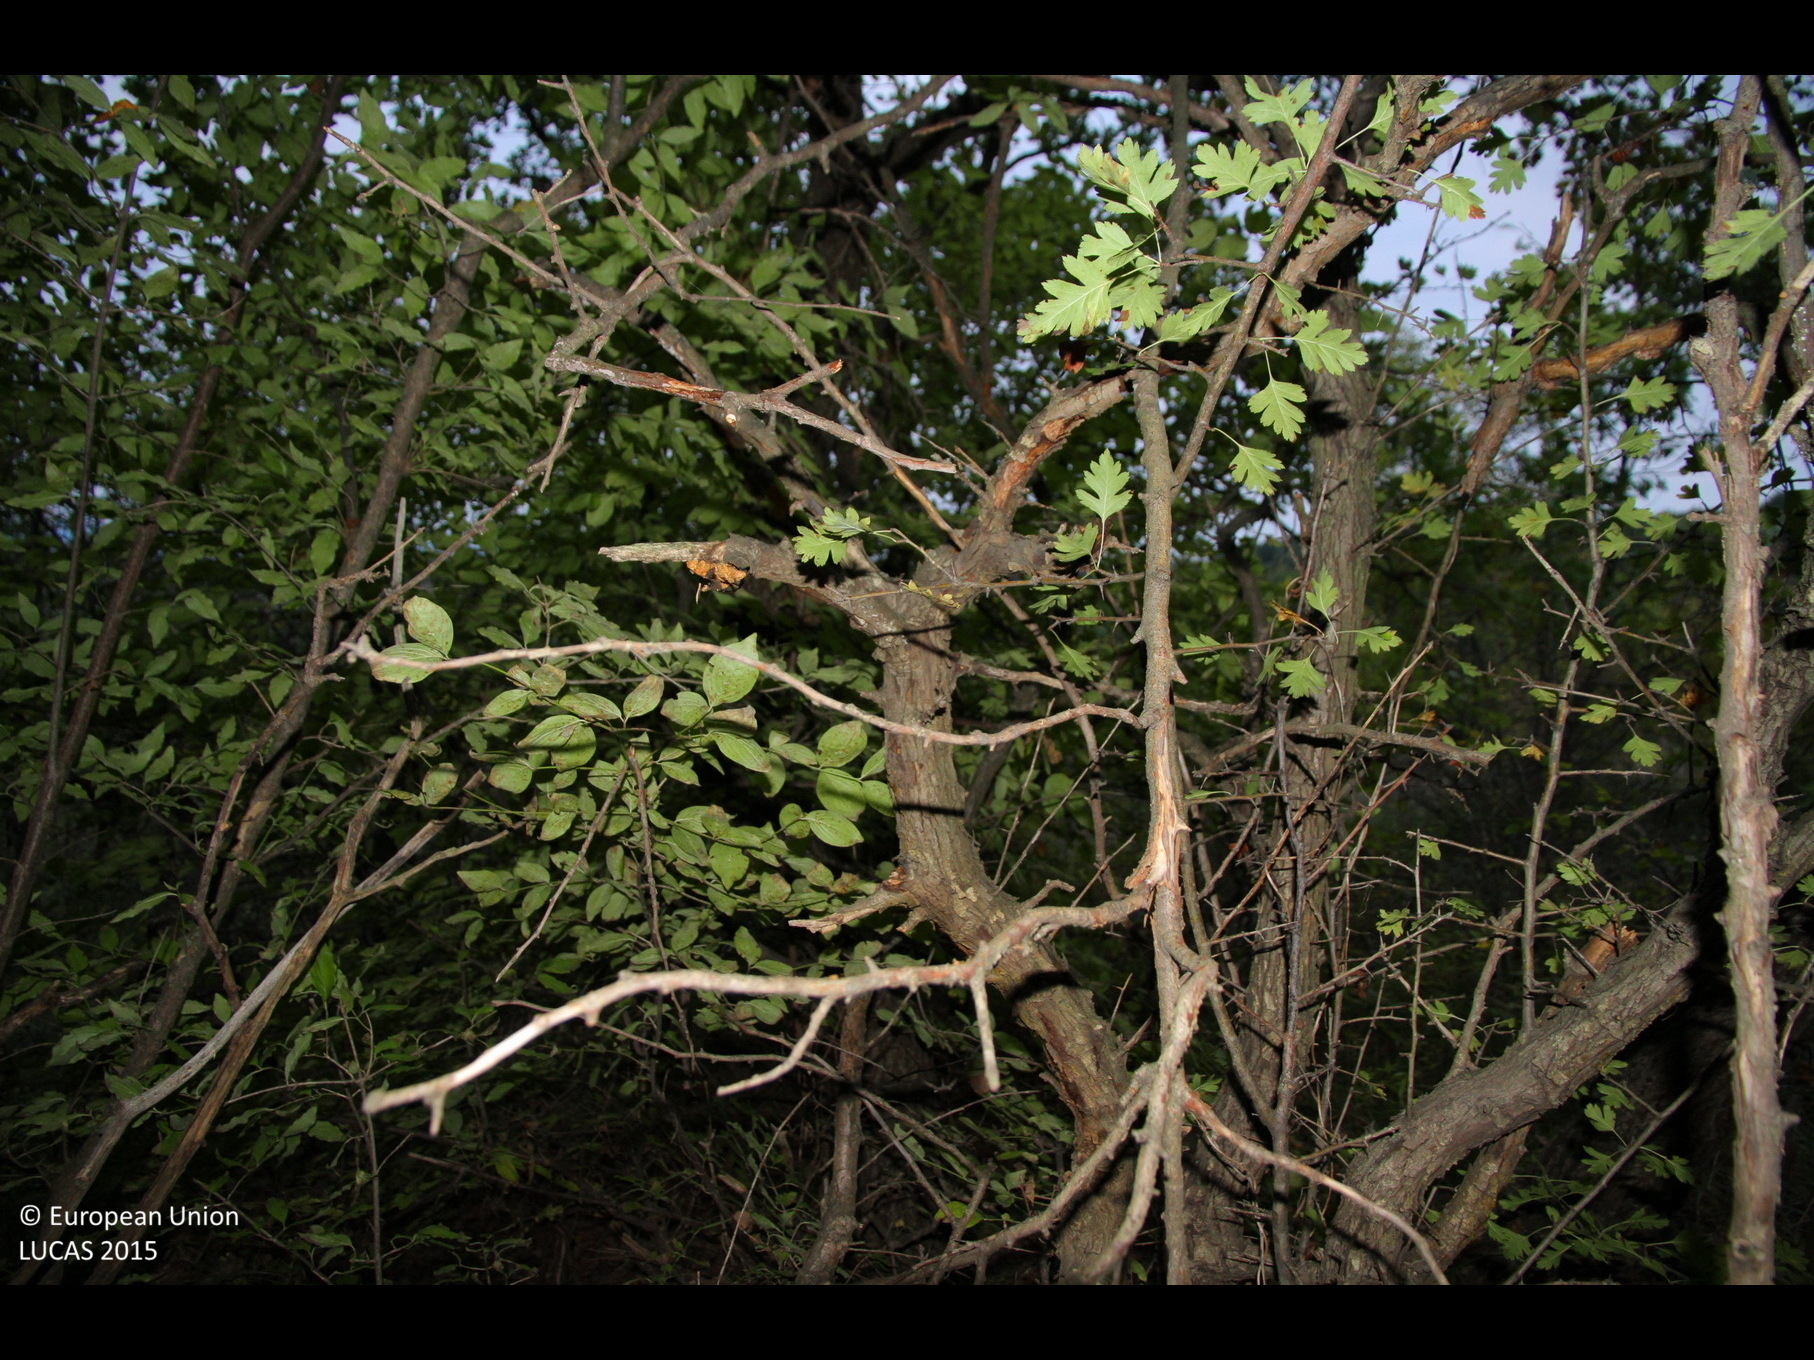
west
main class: Woodland
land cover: Broadleaved woodland
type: beech forest
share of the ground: > 75 %
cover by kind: broadleaved forest trees 100 %
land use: Forestry
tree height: < 5 m
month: October
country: BG
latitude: 43.2318
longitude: 27.0964
